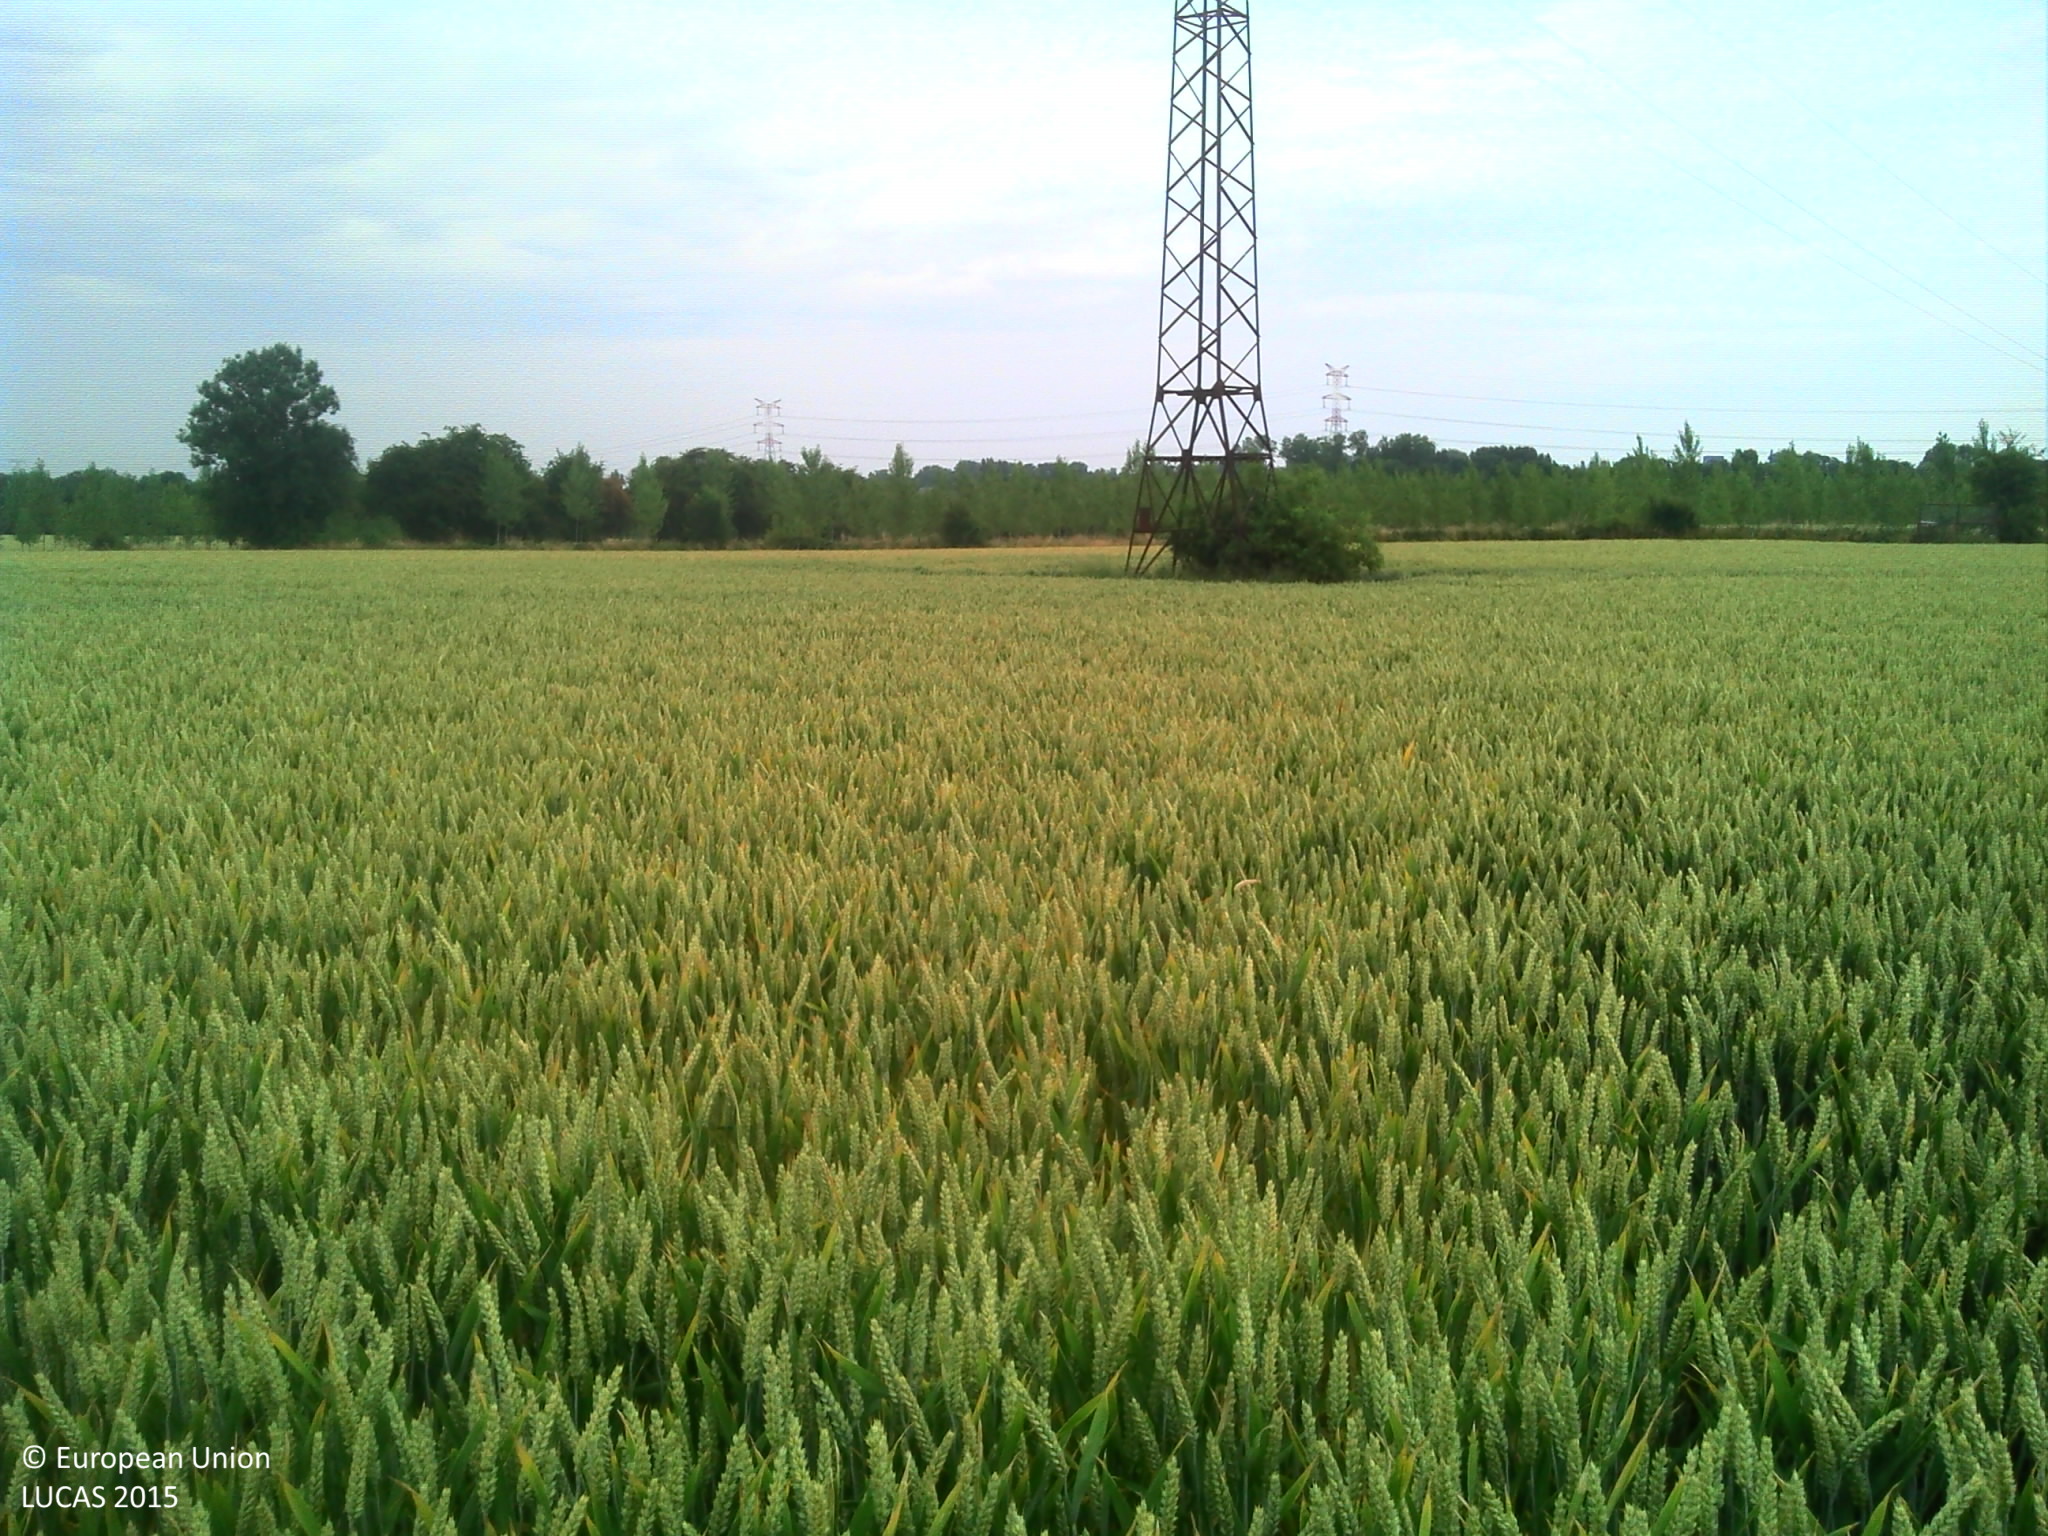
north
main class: Cropland
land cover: Common wheat
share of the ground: > 75 %
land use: Agriculture (excluding fallow land and kitchen gardens)
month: July
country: FR
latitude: 49.9906
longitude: 3.6746
